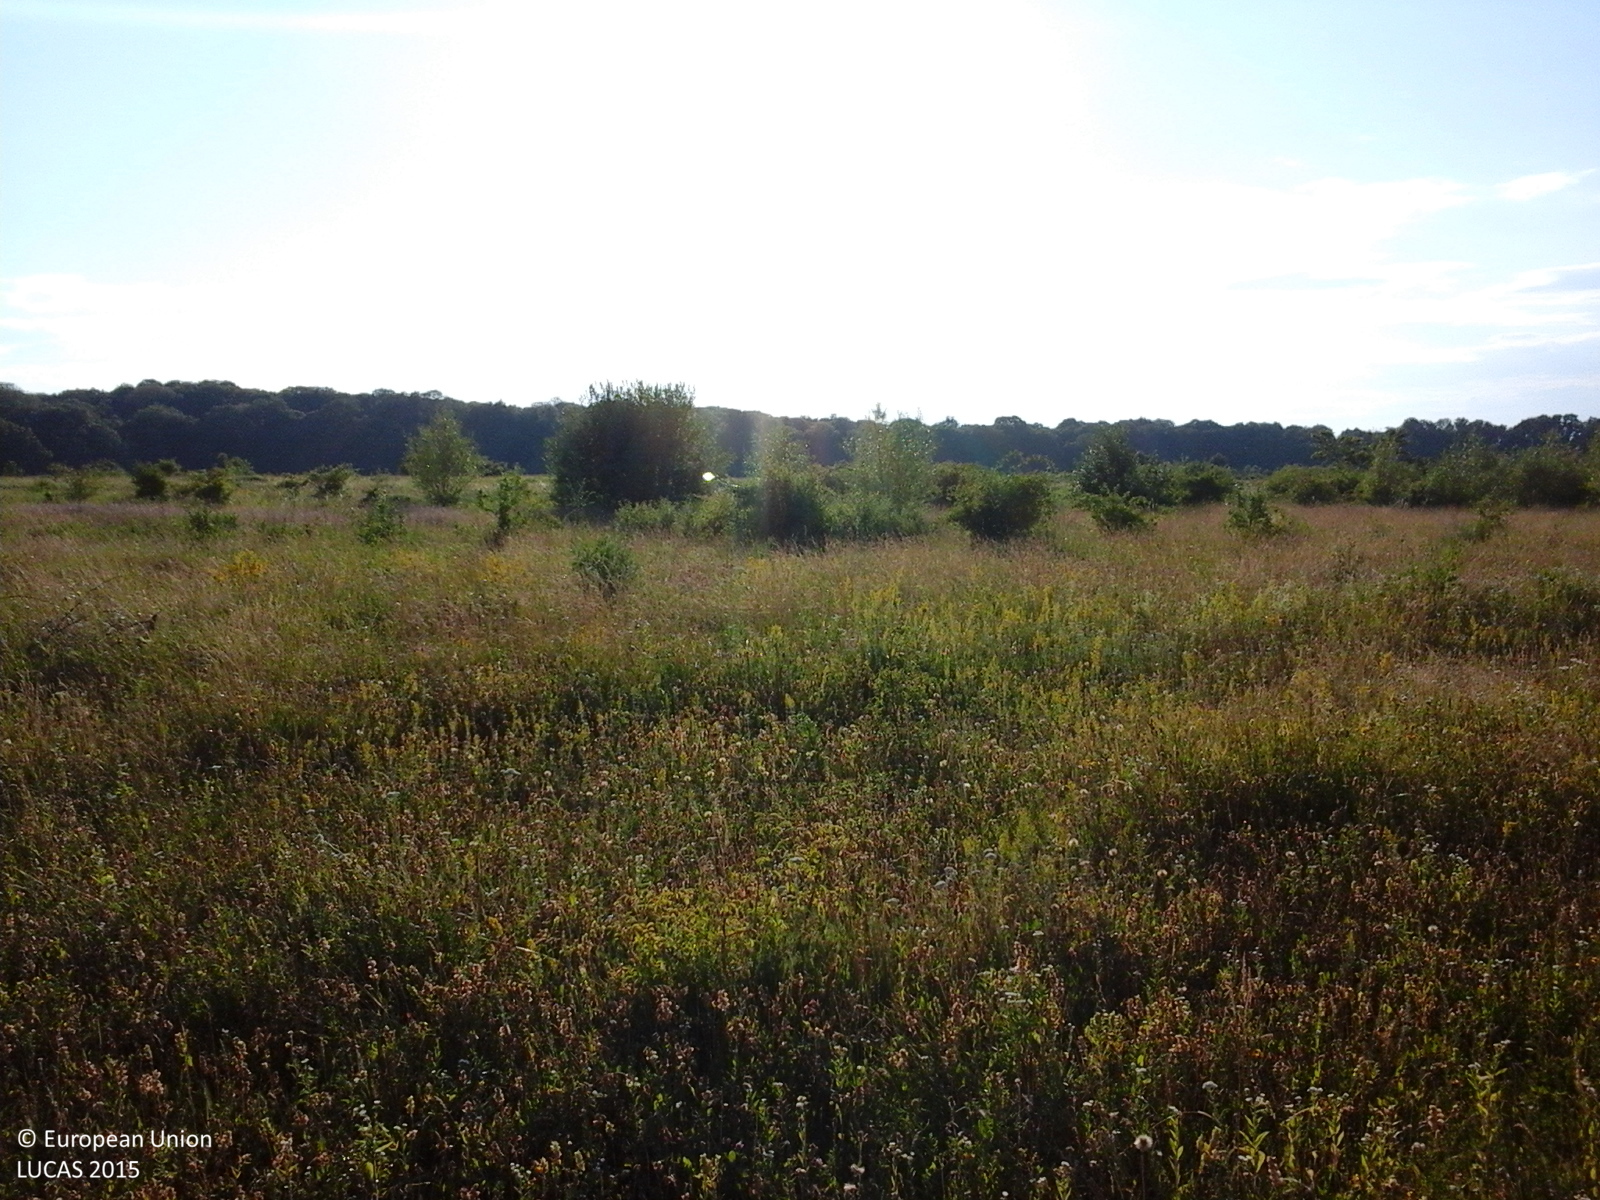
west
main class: Grassland
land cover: Grassland without tree/shrub cover
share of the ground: > 75 %
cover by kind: herbaceous plants 100 %
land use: Agriculture (excluding fallow land and kitchen gardens)
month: June
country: RO
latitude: 47.5951
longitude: 26.8429
